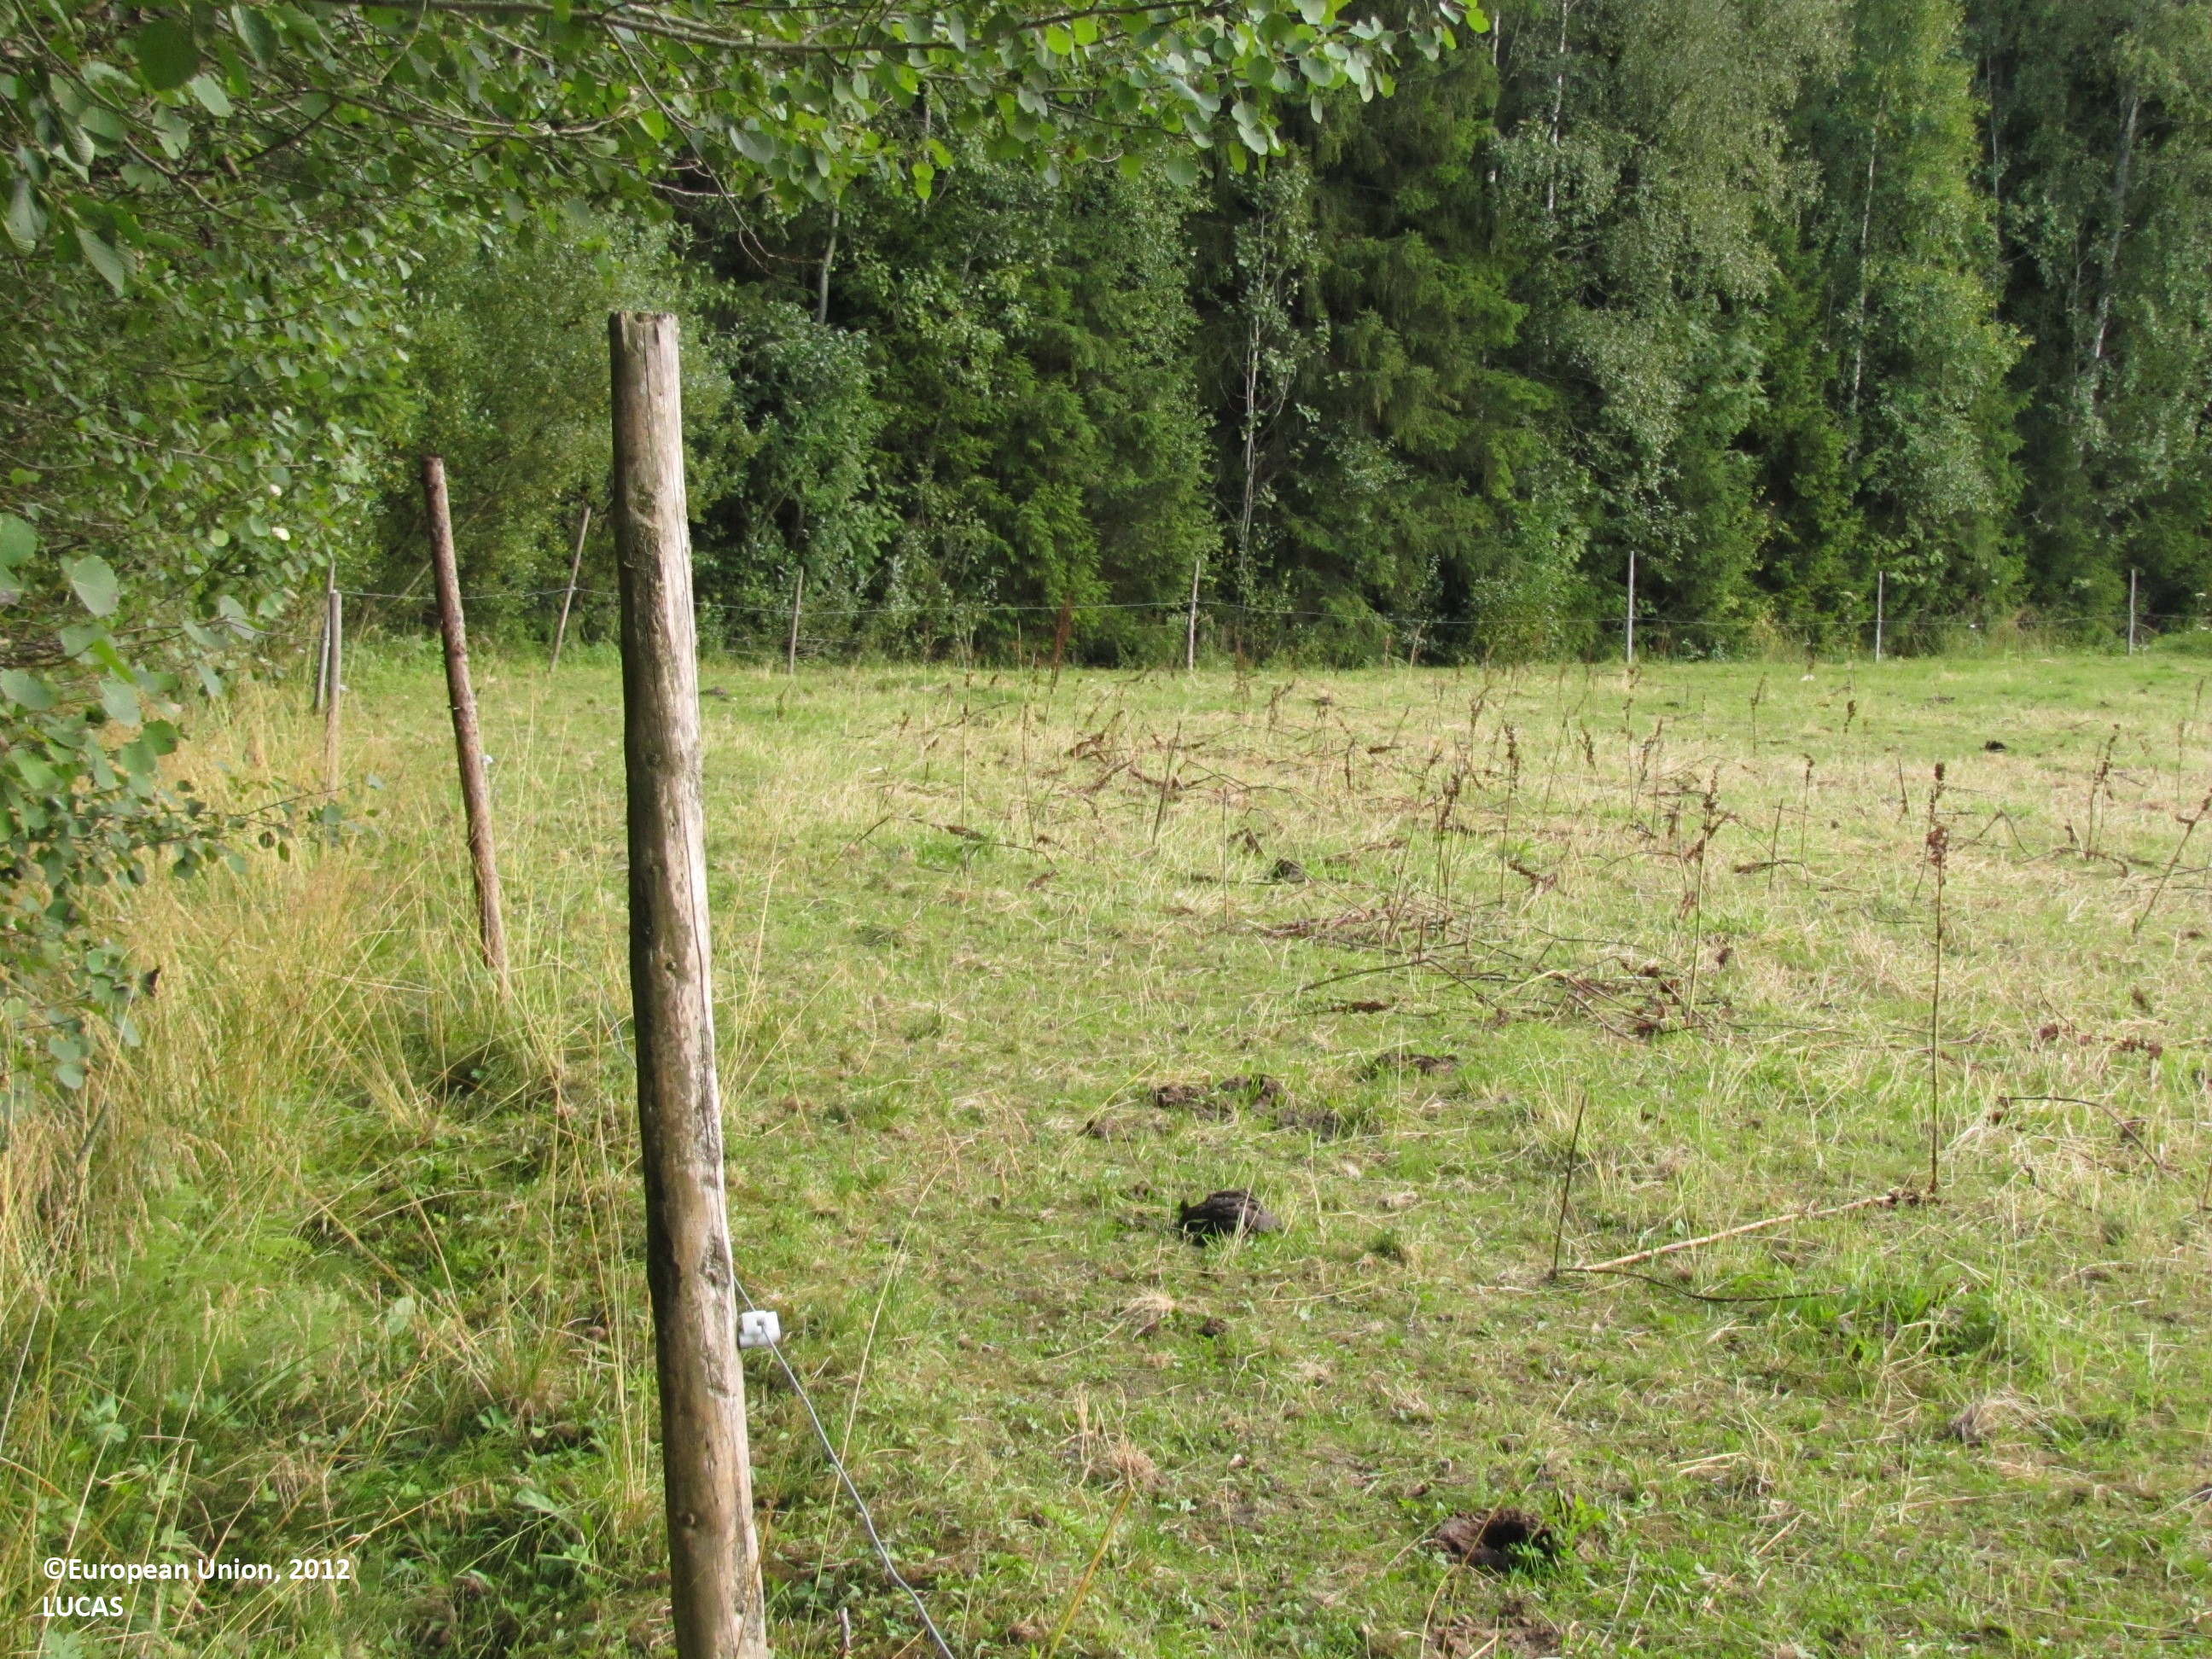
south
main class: Grassland
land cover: Grassland without tree/shrub cover
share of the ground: 50 - 75 %
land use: Agriculture (excluding fallow land and kitchen gardens)
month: August
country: FI
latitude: 61.7412
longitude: 22.9238
